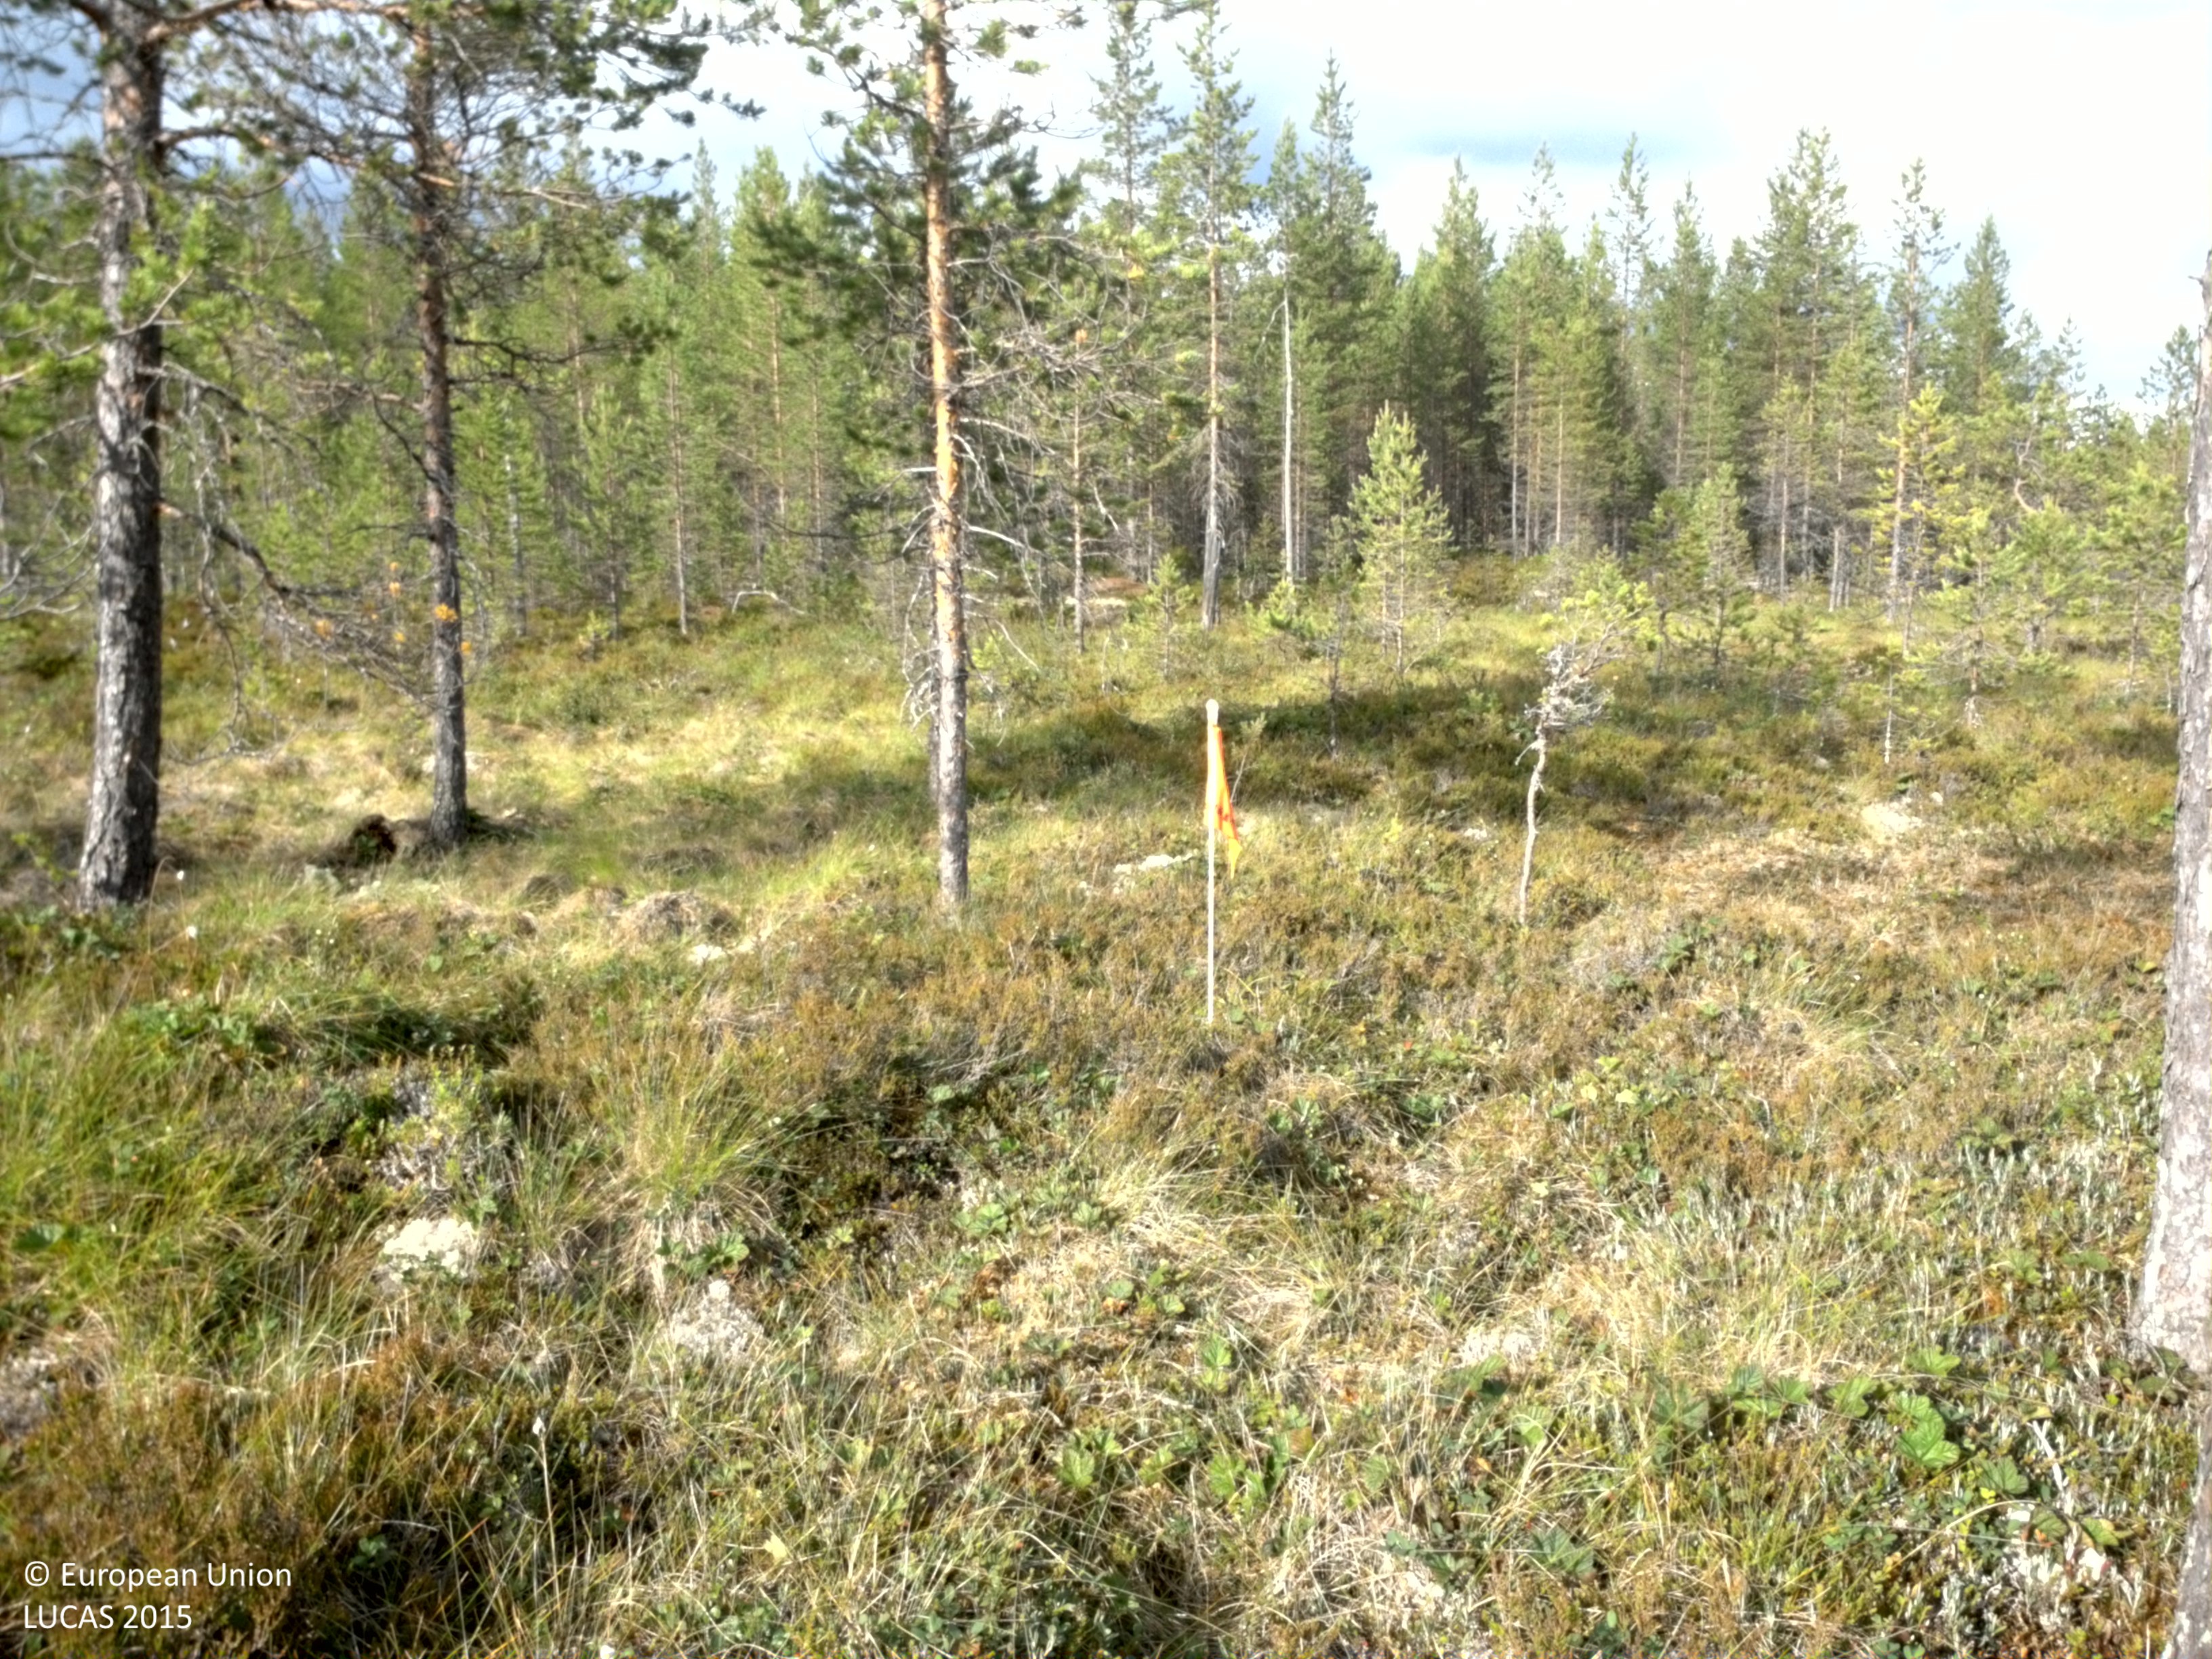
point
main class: Woodland
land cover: Pine dominated coniferous woodland
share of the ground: 10 - 25 %
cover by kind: lichens and mosses 40 %, shrubs 30 %, coniferous forest trees 20 %, herbaceous plants 10 %
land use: Semi-natural and natural areas not in use
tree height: < 5 m
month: July
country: SE
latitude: 61.3256
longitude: 13.5559
